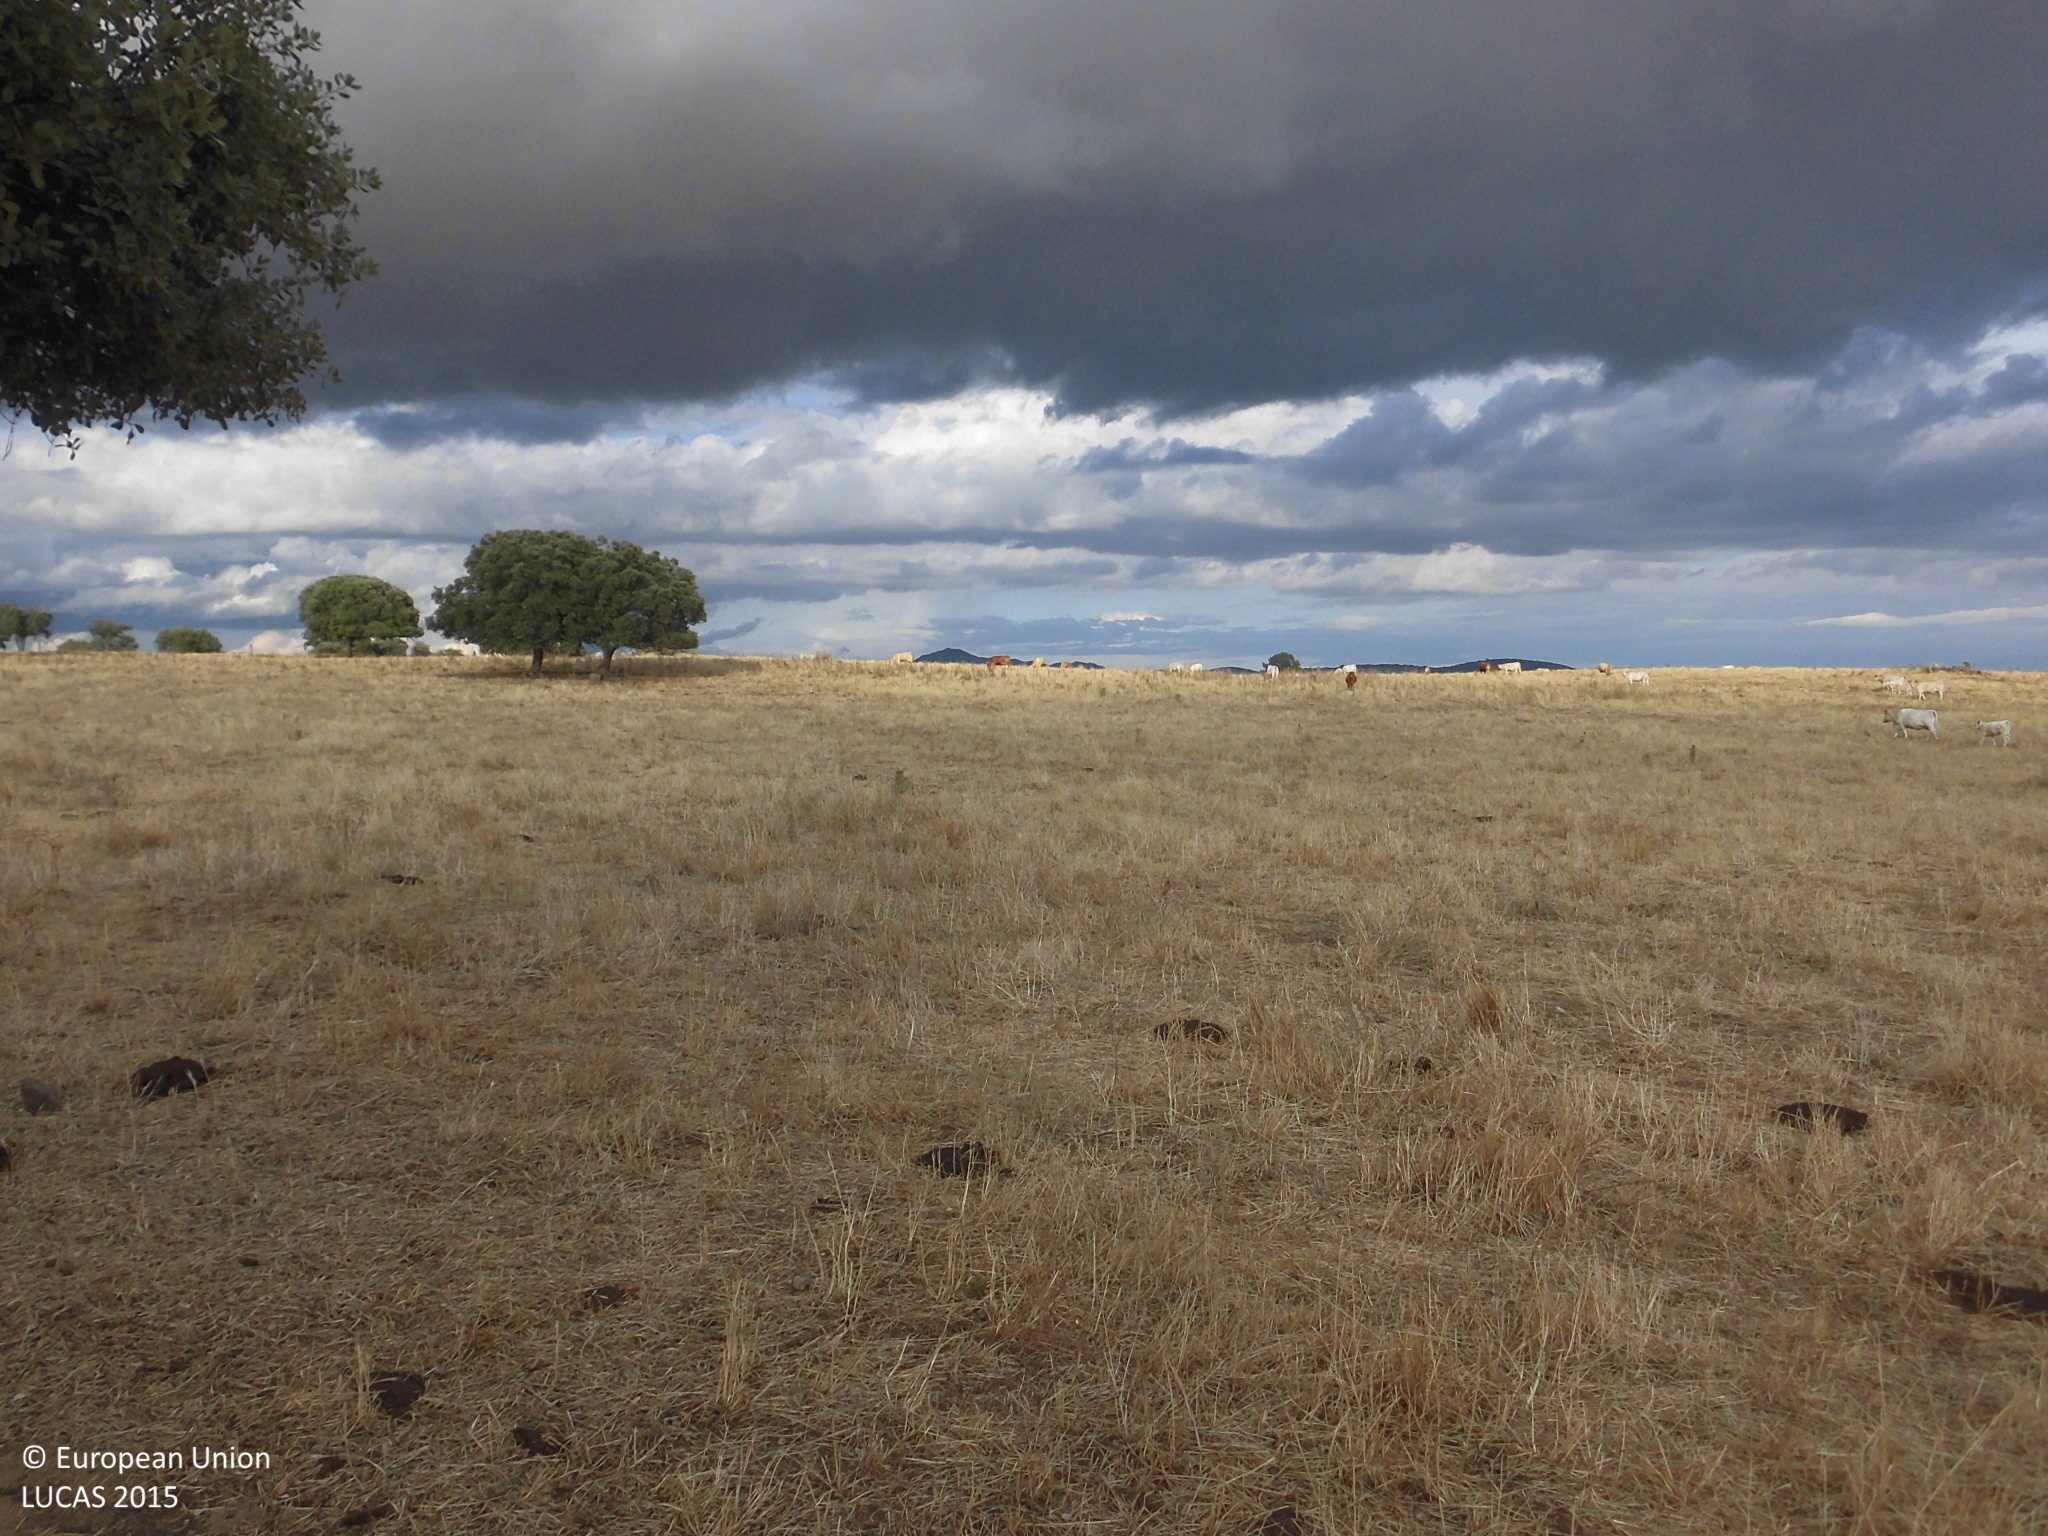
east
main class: Grassland
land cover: Grassland with sparse tree/shrub cover
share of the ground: > 75 %
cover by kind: herbaceous plants 95 %, broadleaved forest trees 5 %
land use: Agriculture (excluding fallow land and kitchen gardens)
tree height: > 5 m
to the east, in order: Grassland with sparse tree/shrub cover; Grassland without tree/shrub cover; Grassland with sparse tree/shrub cover; Fences; Broadleaved woodland
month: June
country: ES
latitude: 39.3372
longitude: -5.9639
